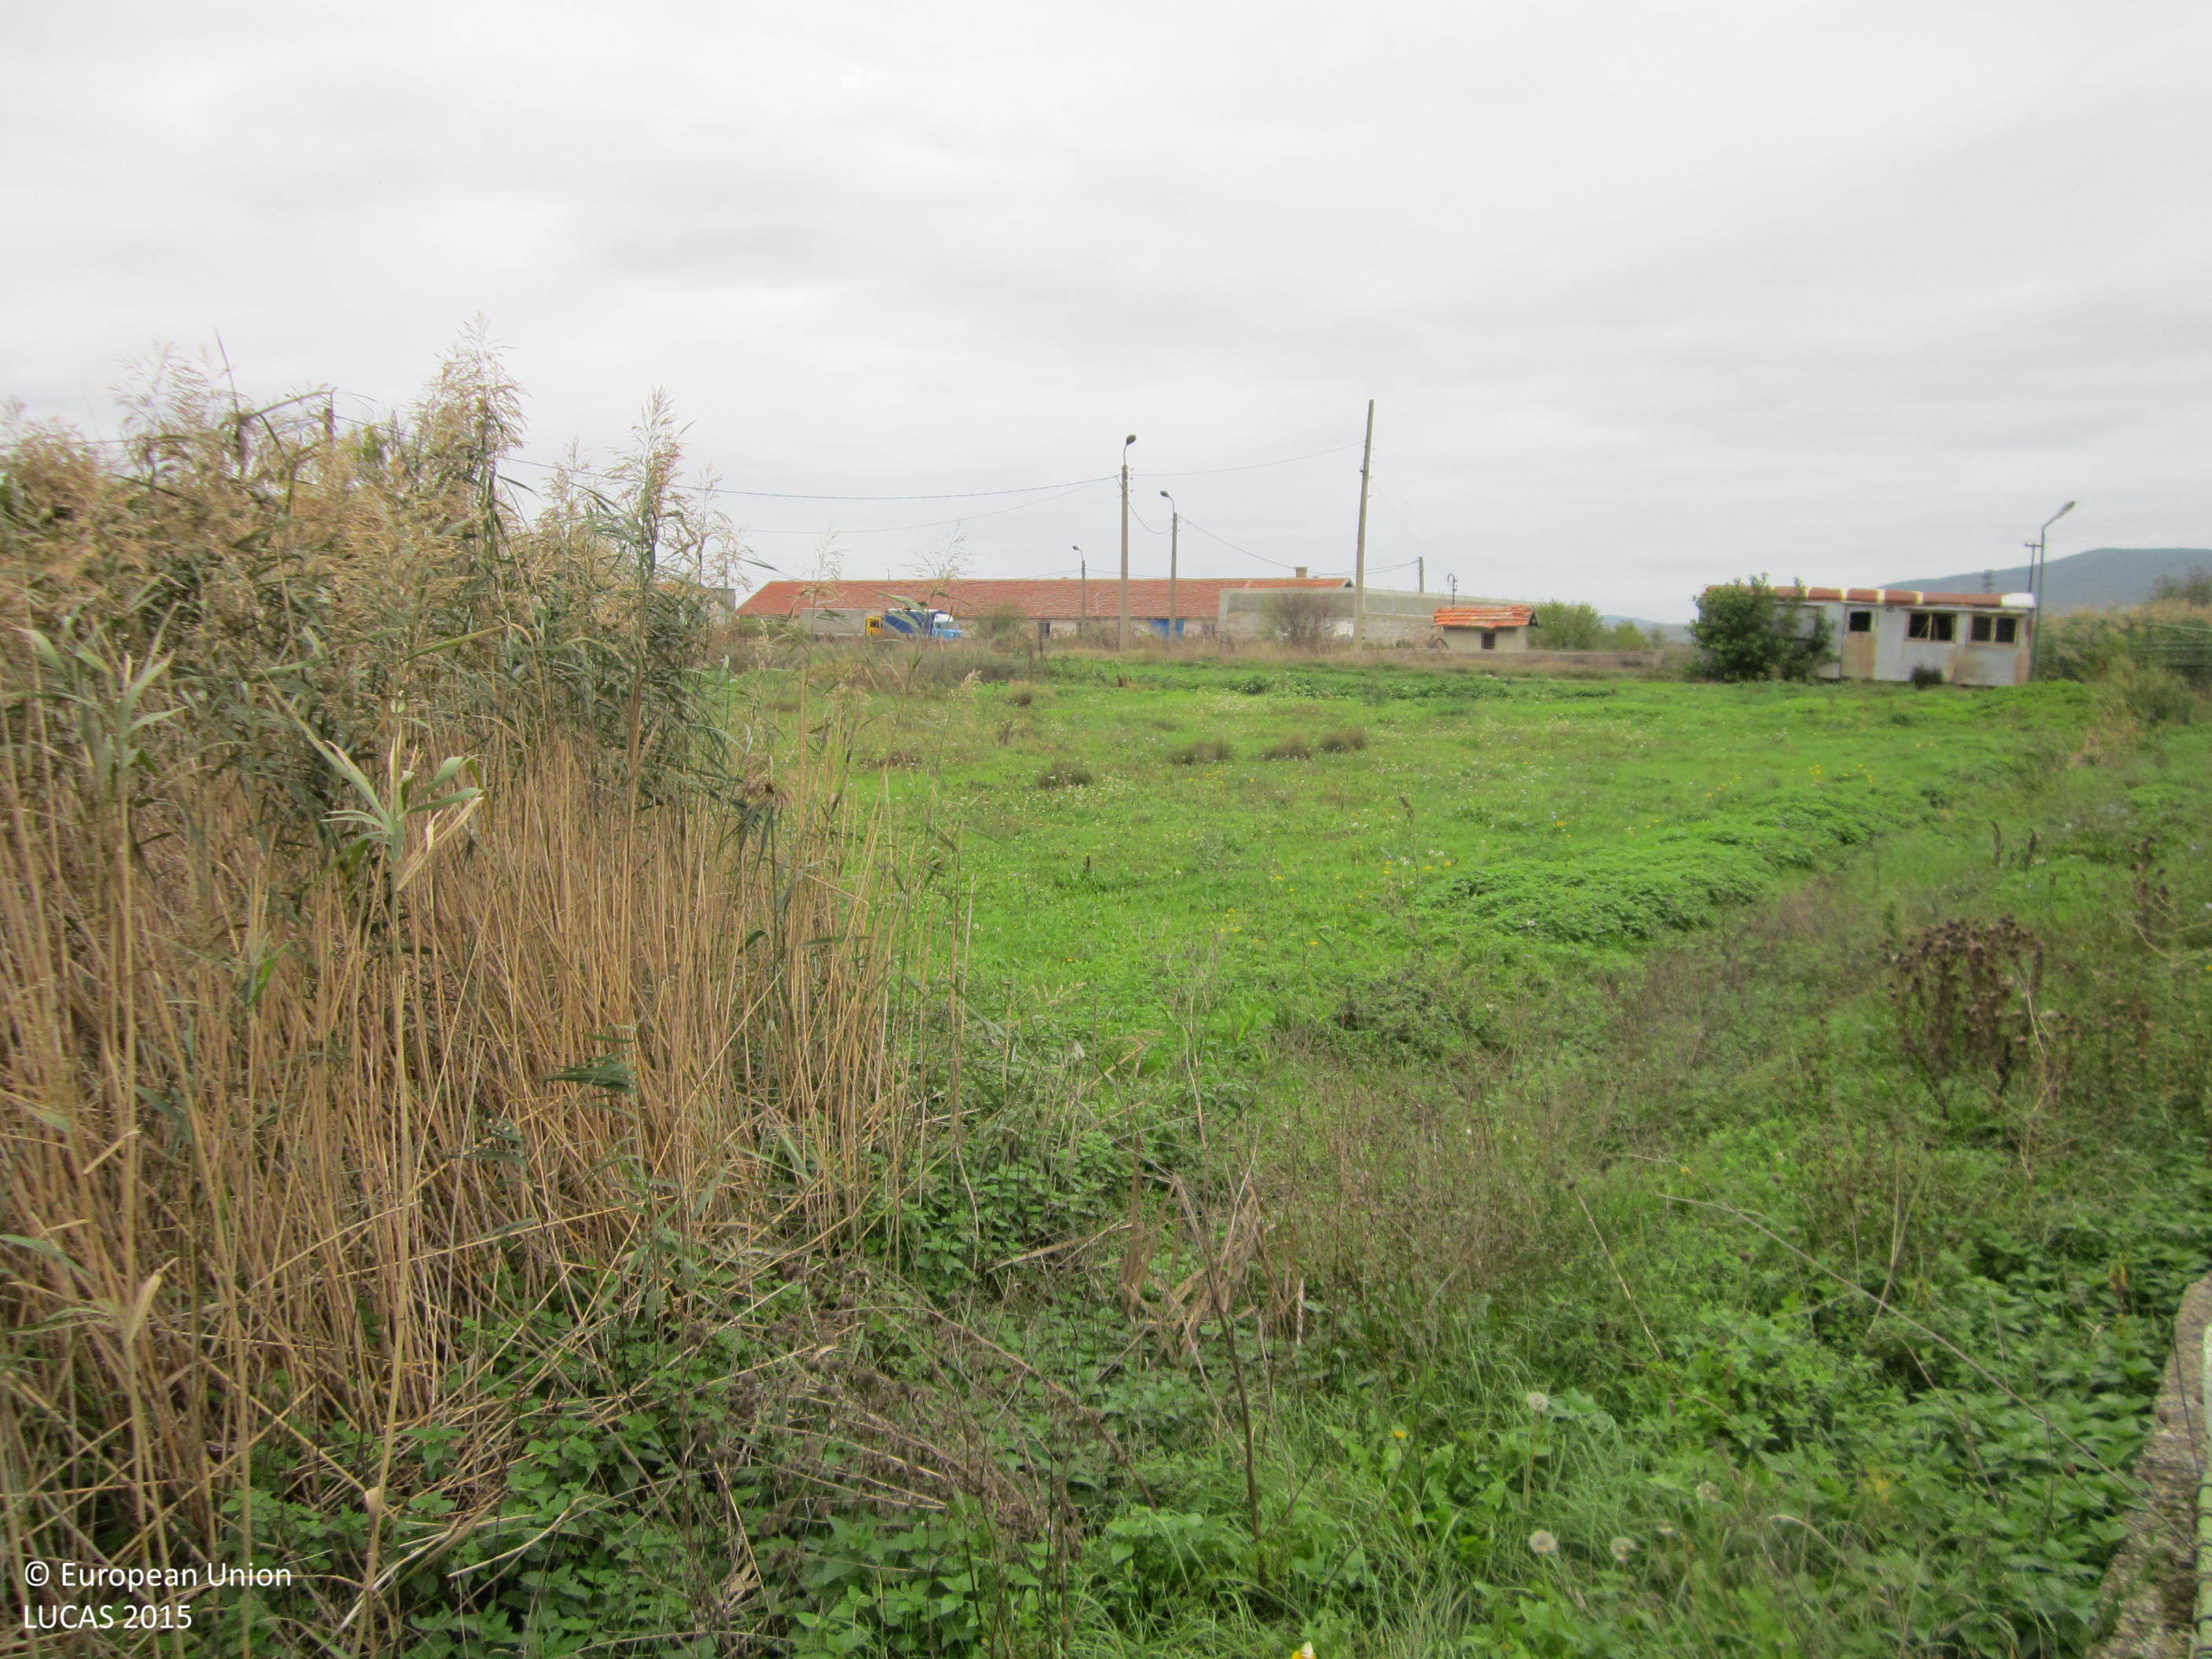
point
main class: Grassland
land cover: Spontaneously vegetated surfaces
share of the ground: > 75 %
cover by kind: herbaceous plants 100 %
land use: Fallow land
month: October
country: BG
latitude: 42.7165
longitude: 27.0951
